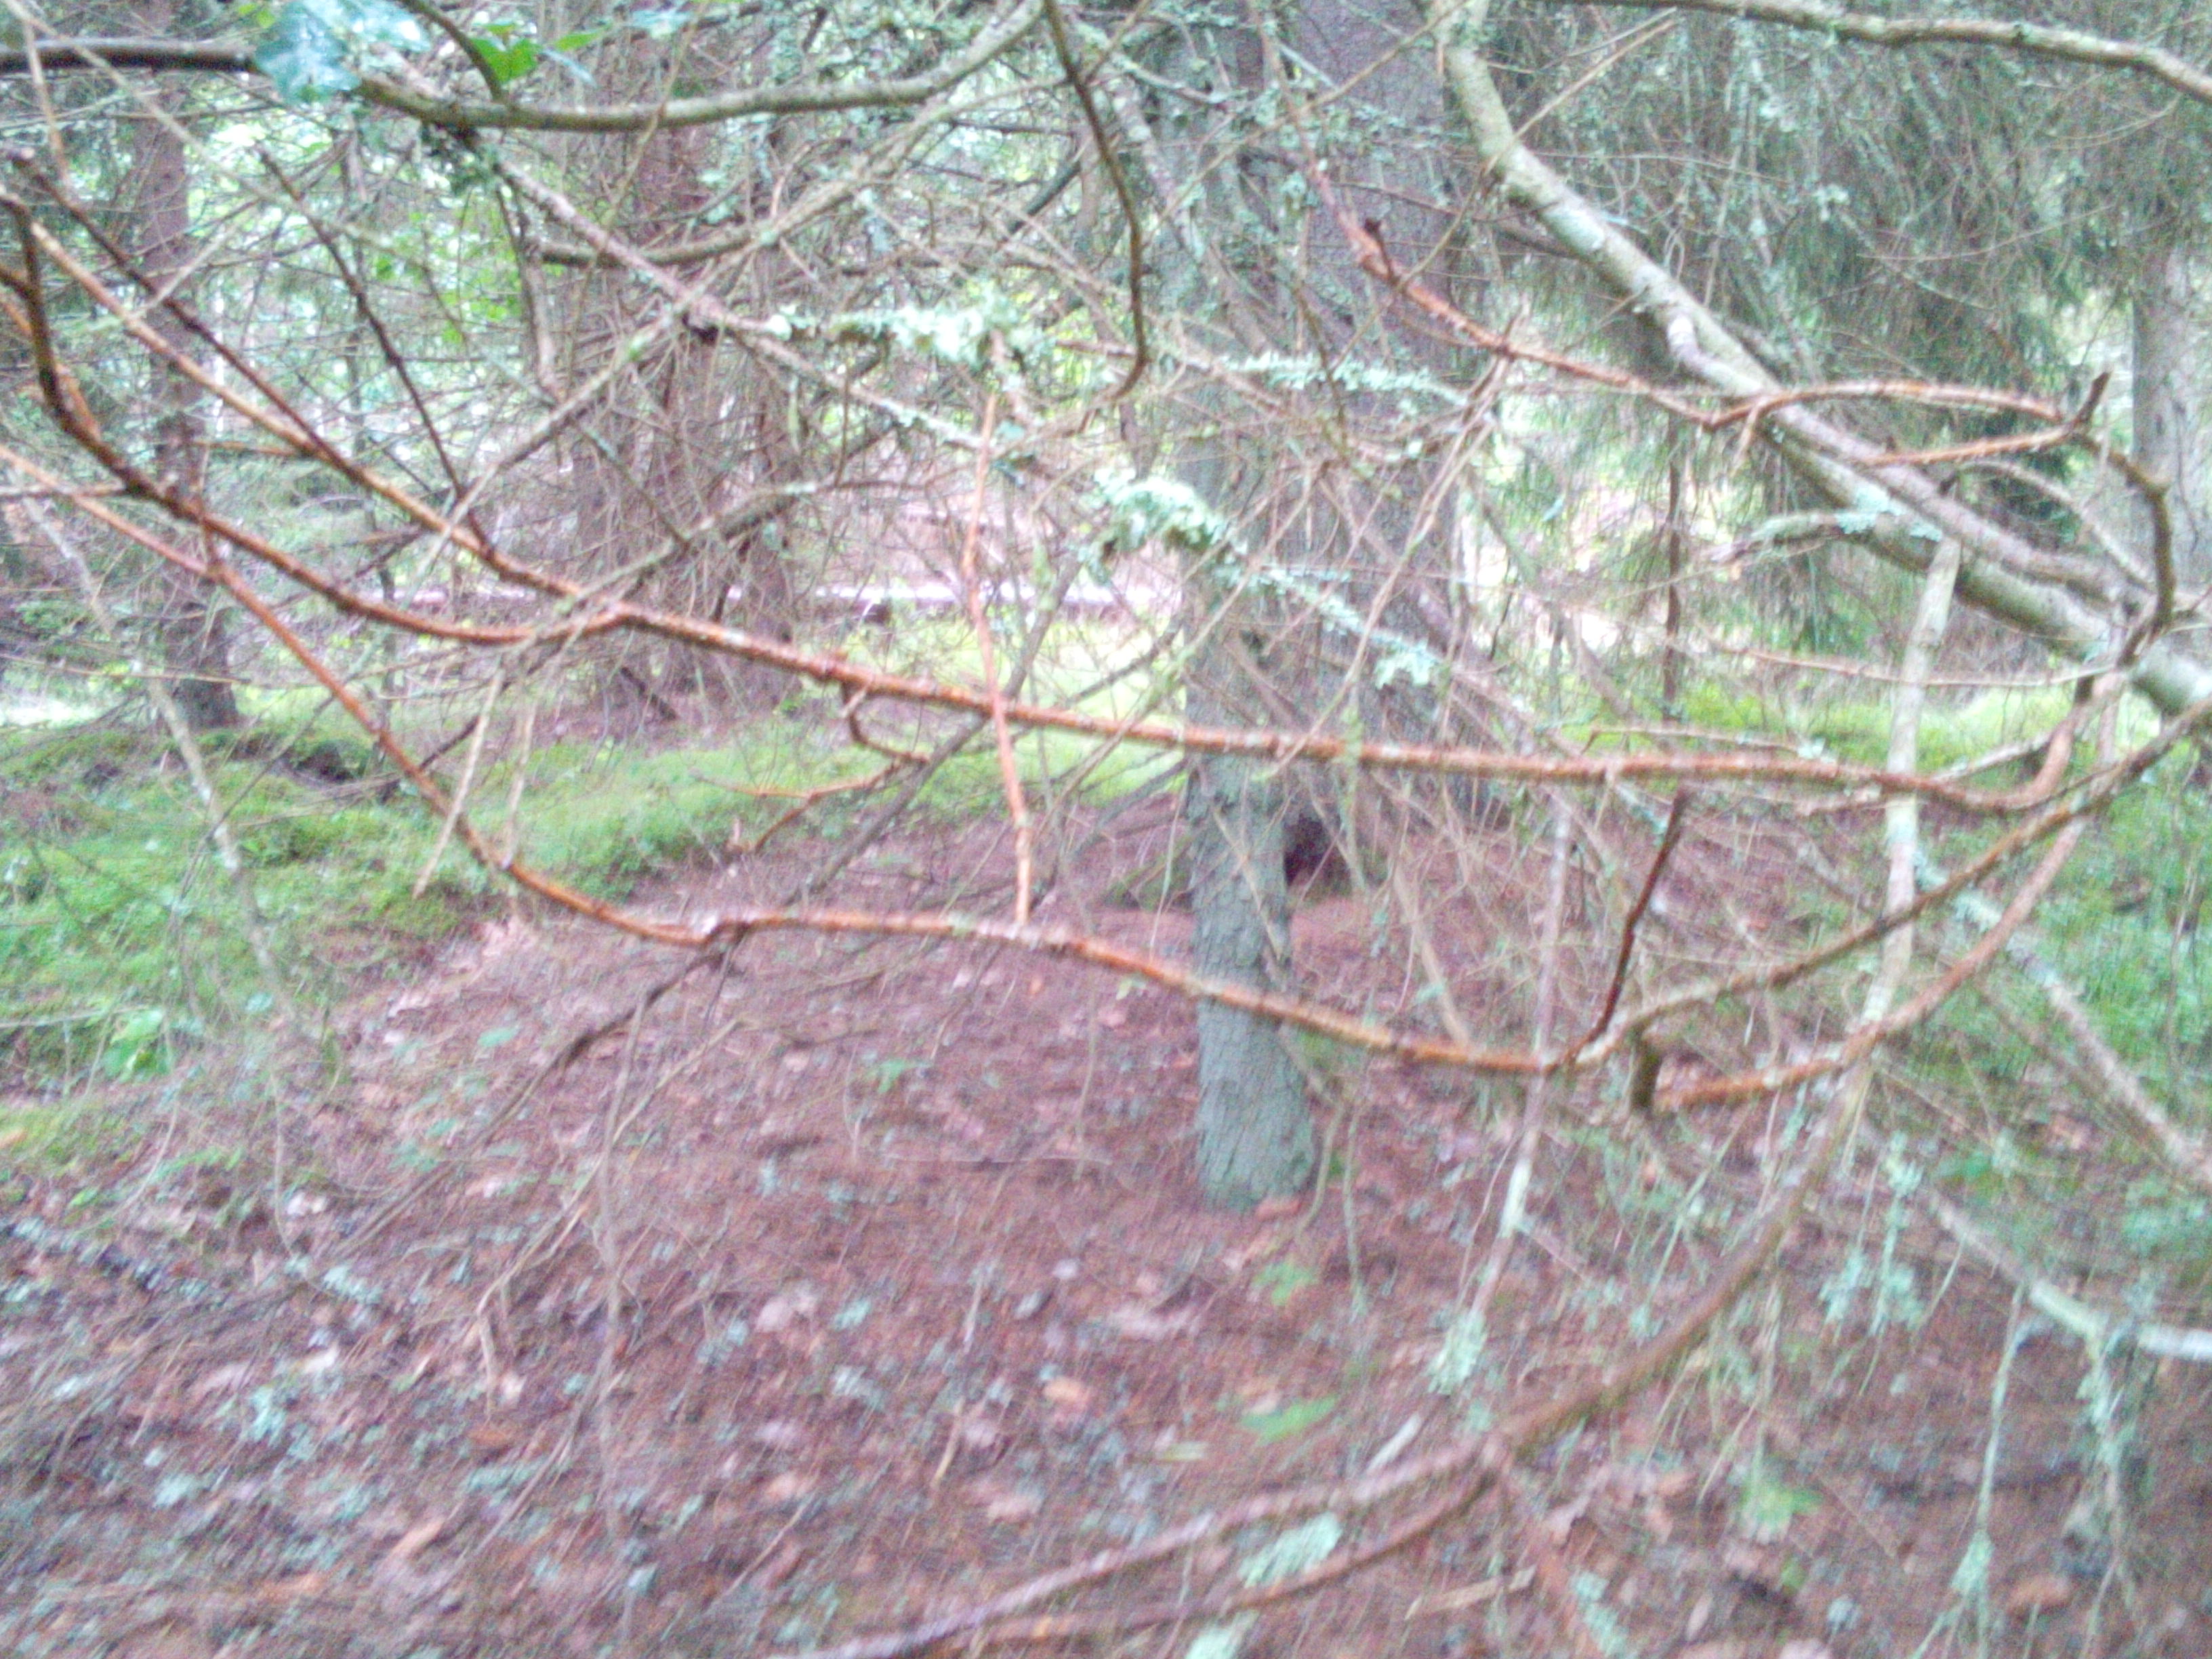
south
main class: Woodland
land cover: Spruce dominated coniferous woodland
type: hemiboreal forest and nemoral coniferous forest and mixed broadleaved-coniferous forest
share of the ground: > 75 %
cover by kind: coniferous forest trees 75 %, herbaceous plants 10 %, lichens and mosses 10 %, broadleaved forest trees 5 %
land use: Forestry
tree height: > 5 m
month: July
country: LV
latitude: 57.0101
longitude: 21.9523
